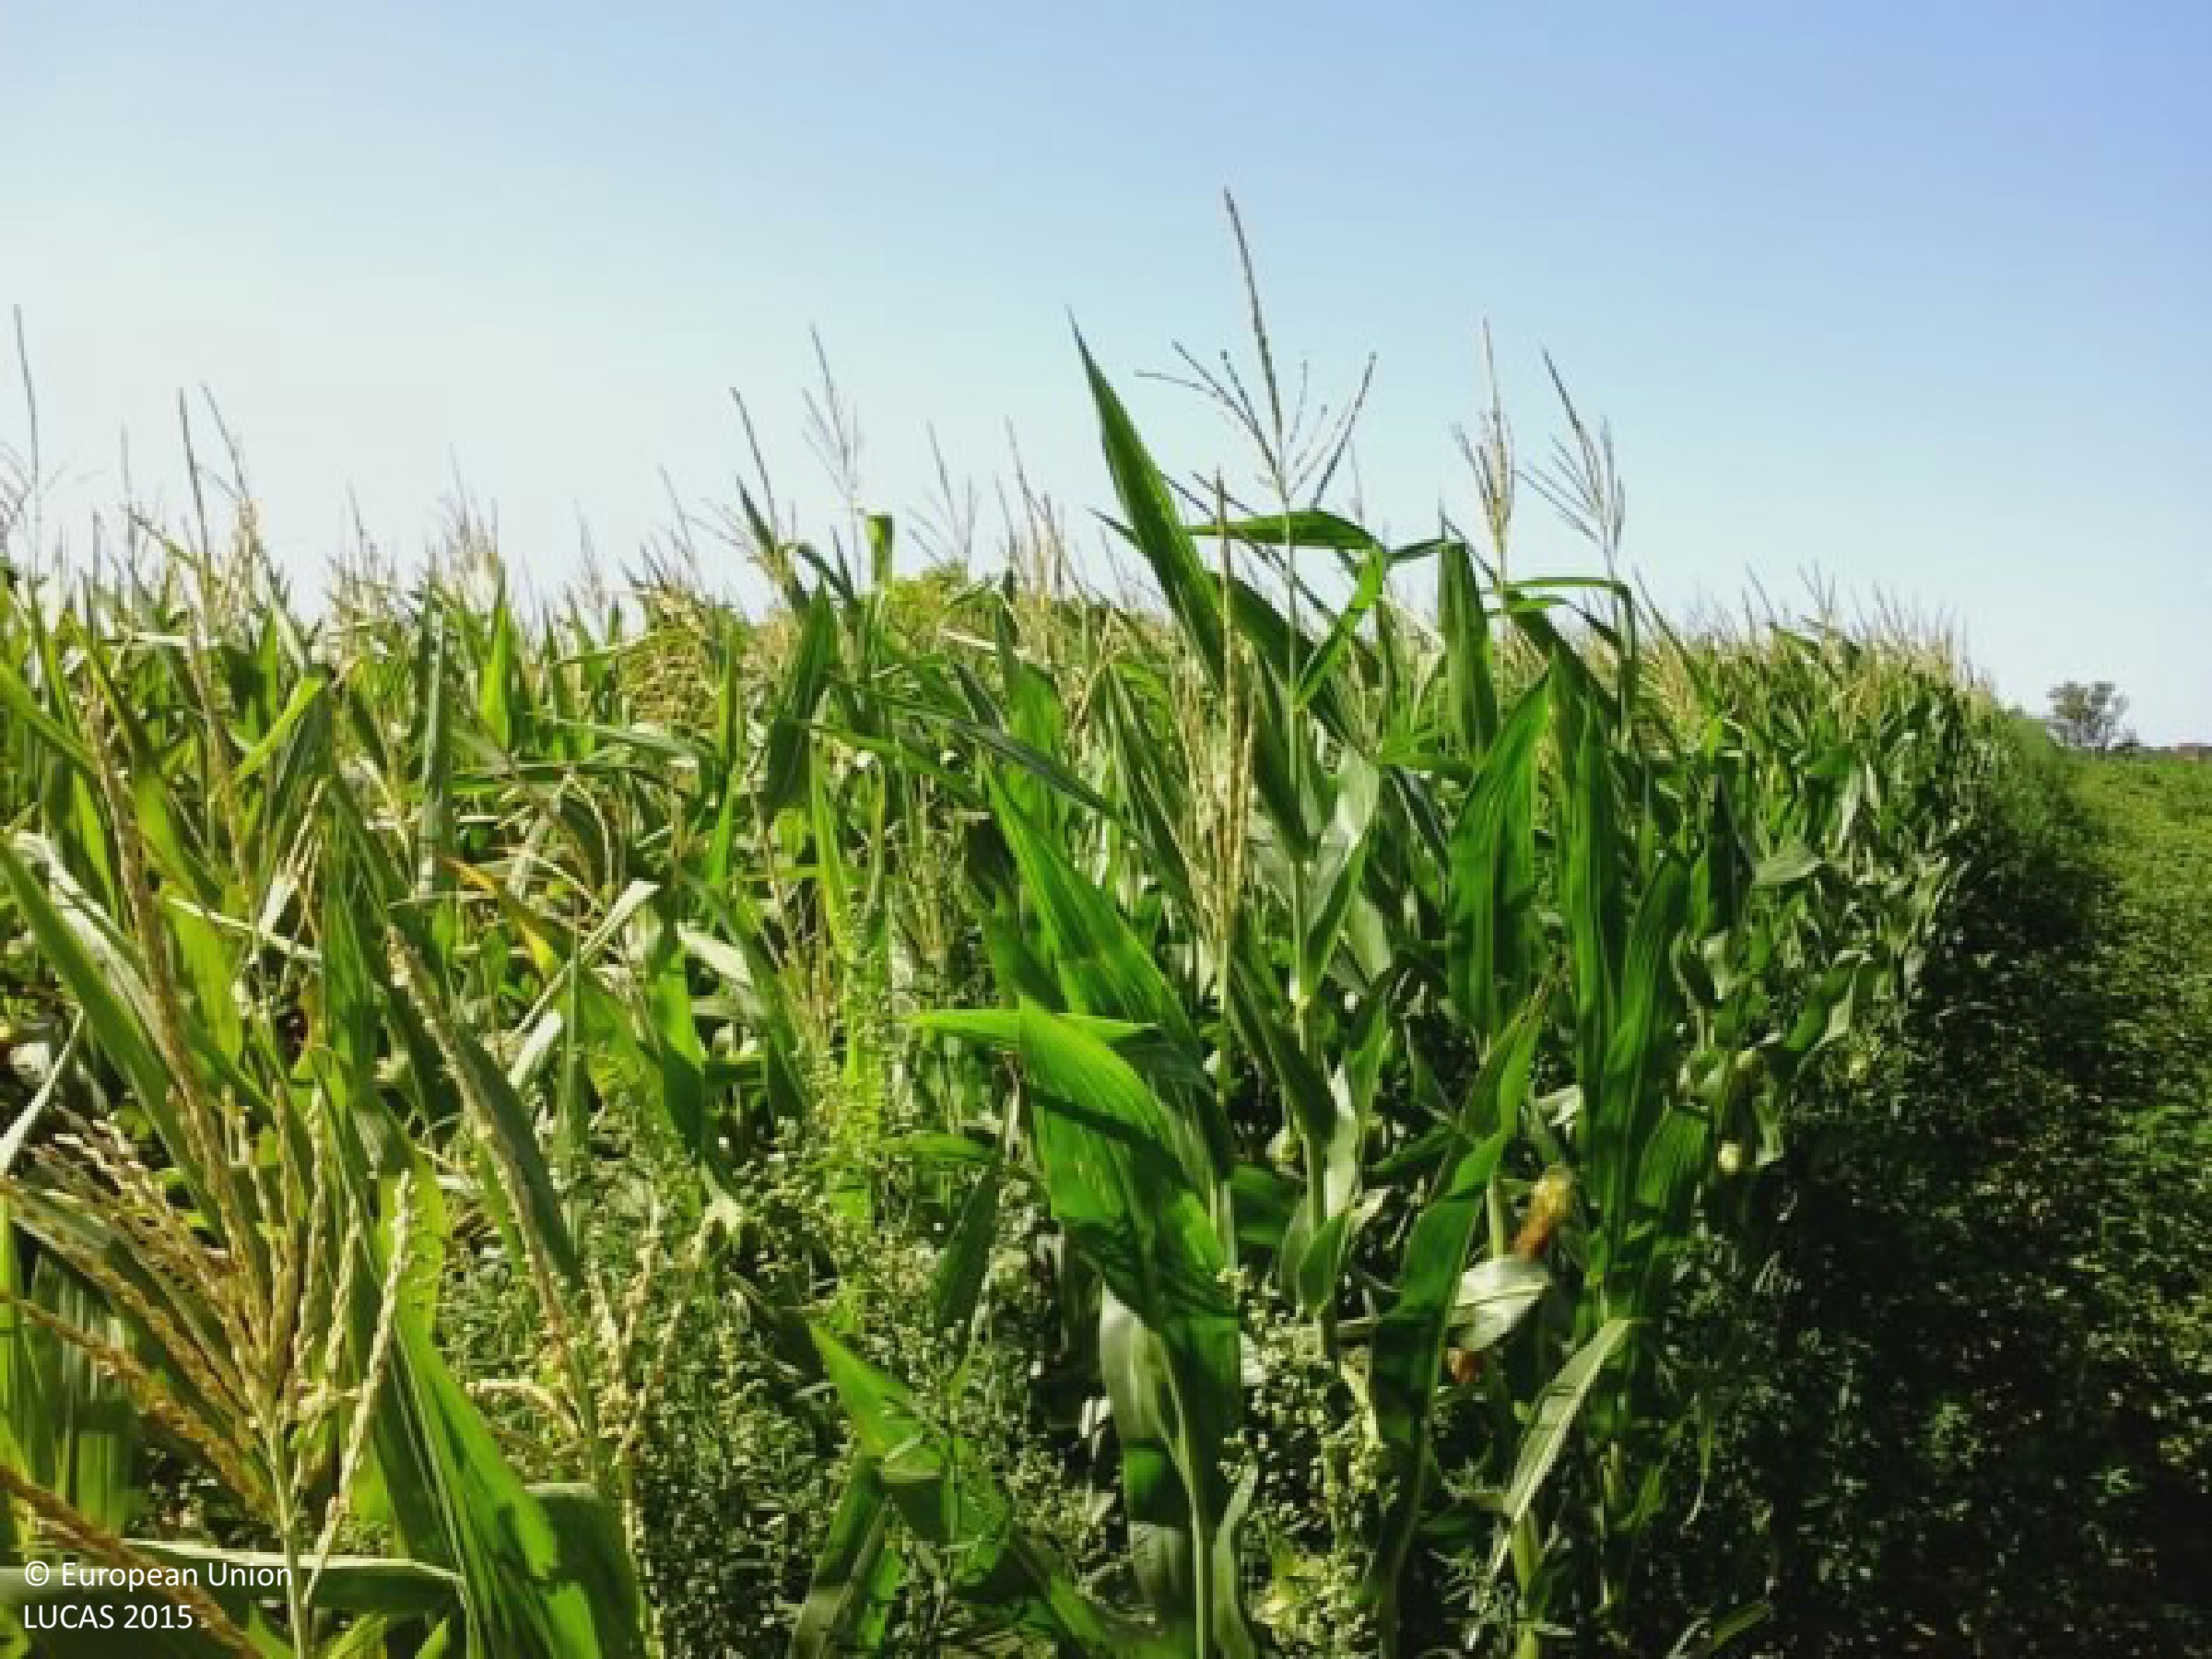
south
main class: Cropland
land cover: Potatoes
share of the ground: 50 - 75 %
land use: Agriculture (excluding fallow land and kitchen gardens)
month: July
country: HU
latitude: 47.3141
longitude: 19.1857
